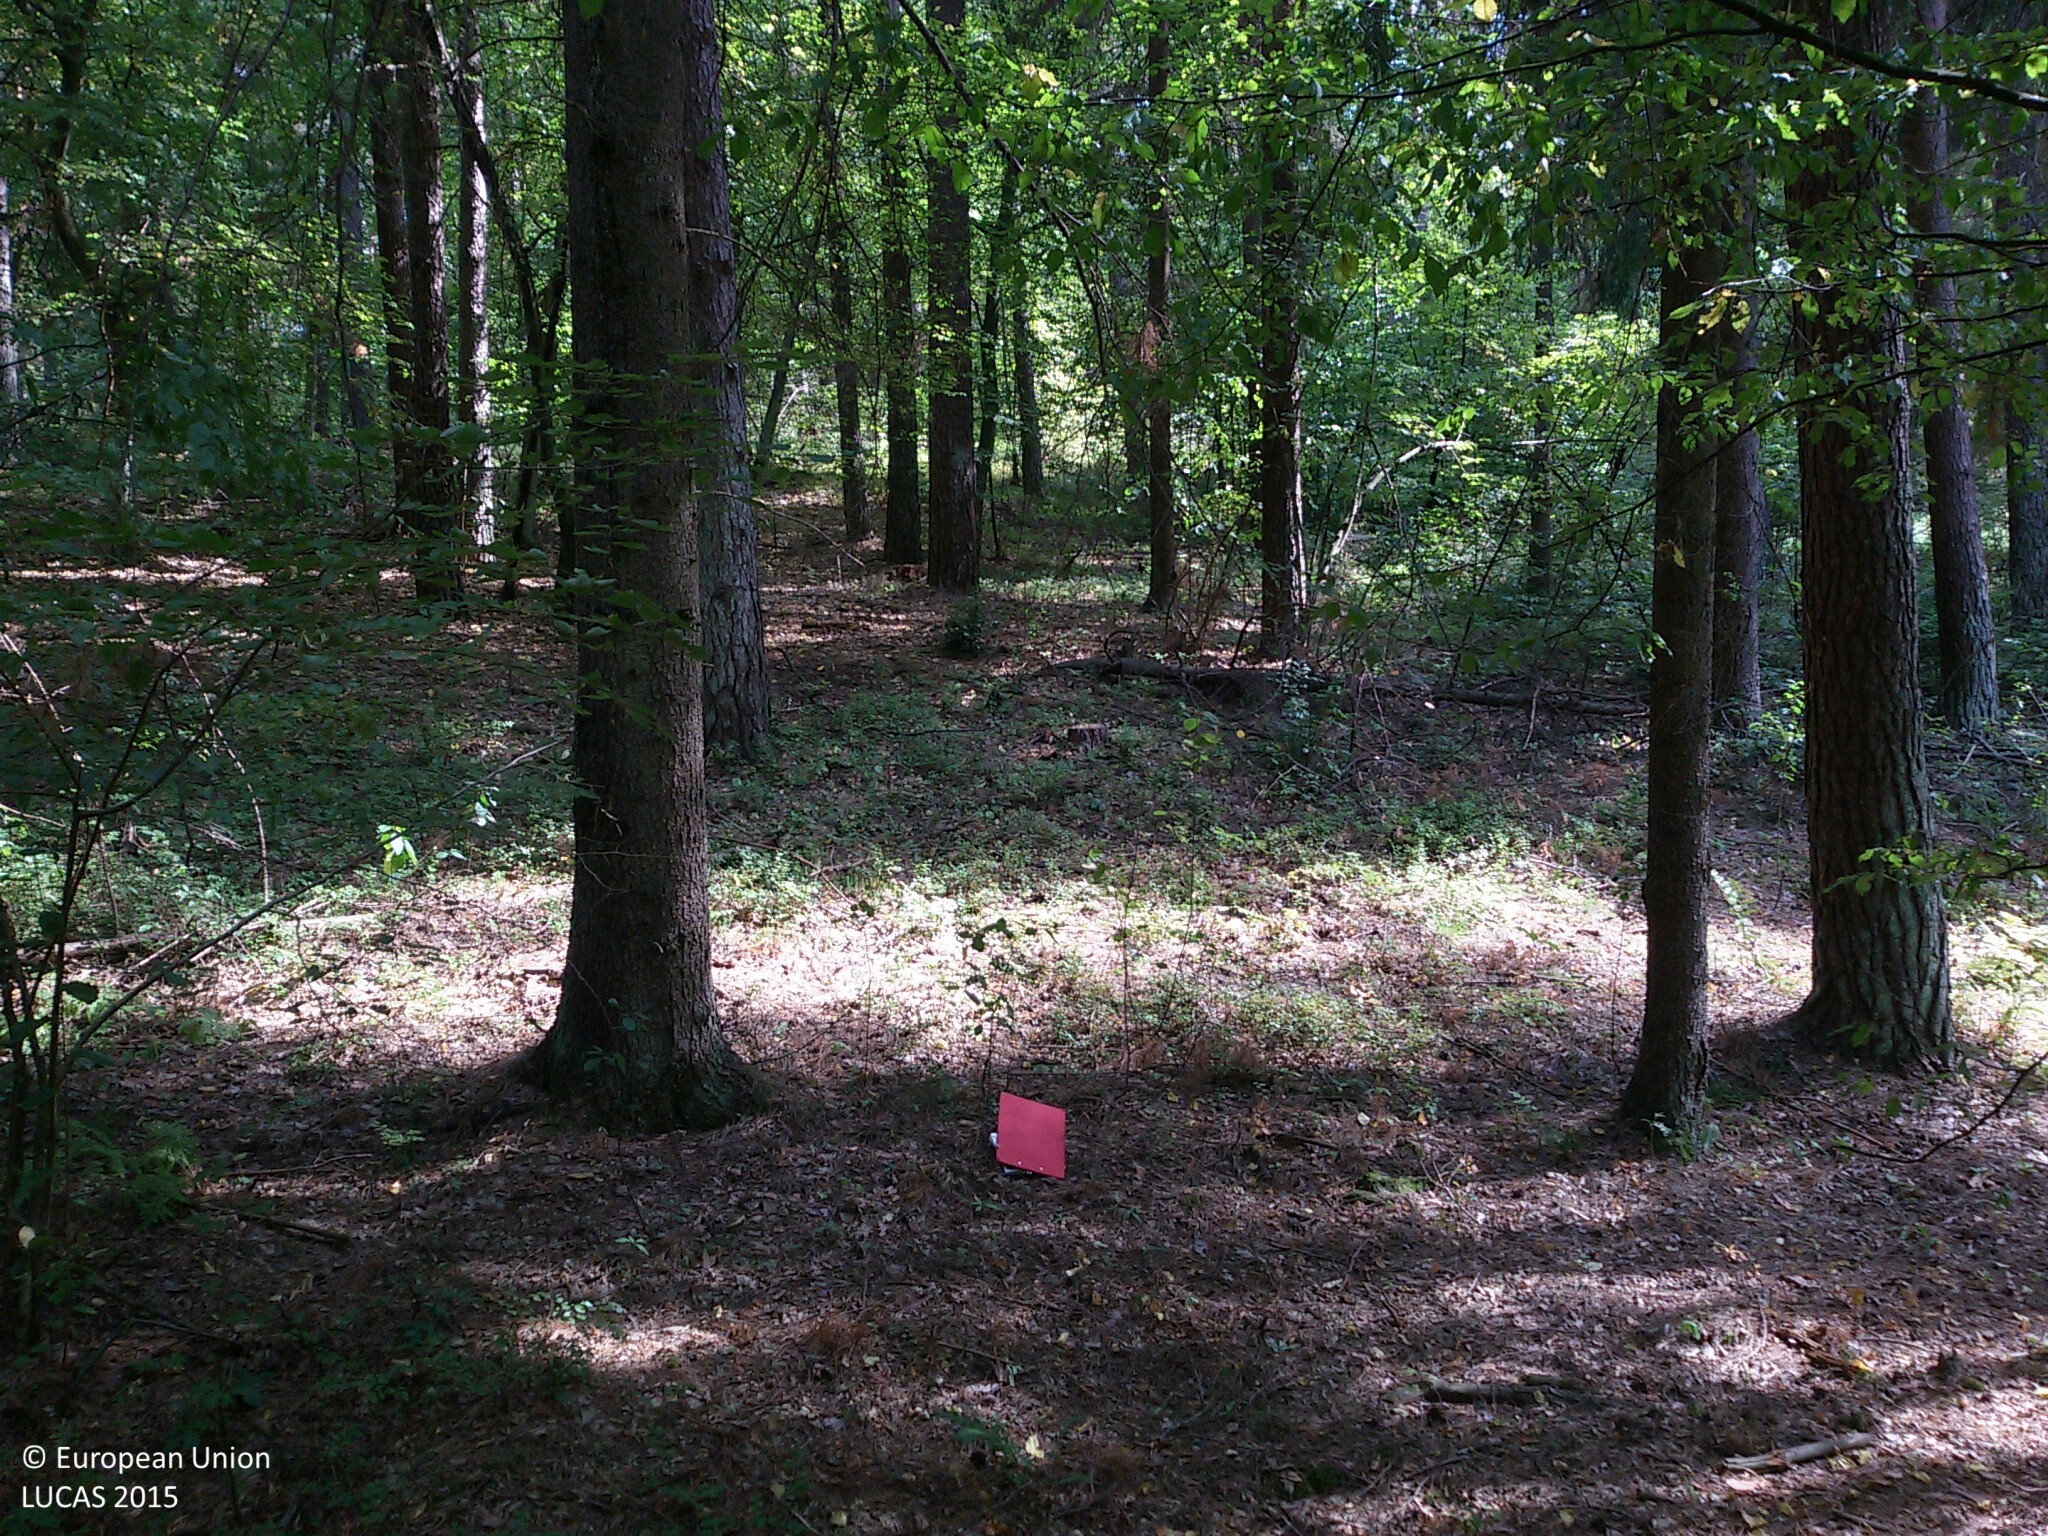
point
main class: Woodland
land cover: Pine dominated mixed woodland
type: hemiboreal forest and nemoral coniferous forest and mixed broadleaved-coniferous forest
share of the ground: > 75 %
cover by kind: coniferous forest trees 65 %, broadleaved forest trees 25 %, herbaceous plants 5 %, unconsolidated bare surface 5 %
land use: Forestry
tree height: > 5 m
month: August
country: PL
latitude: 53.5712
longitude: 20.1660
